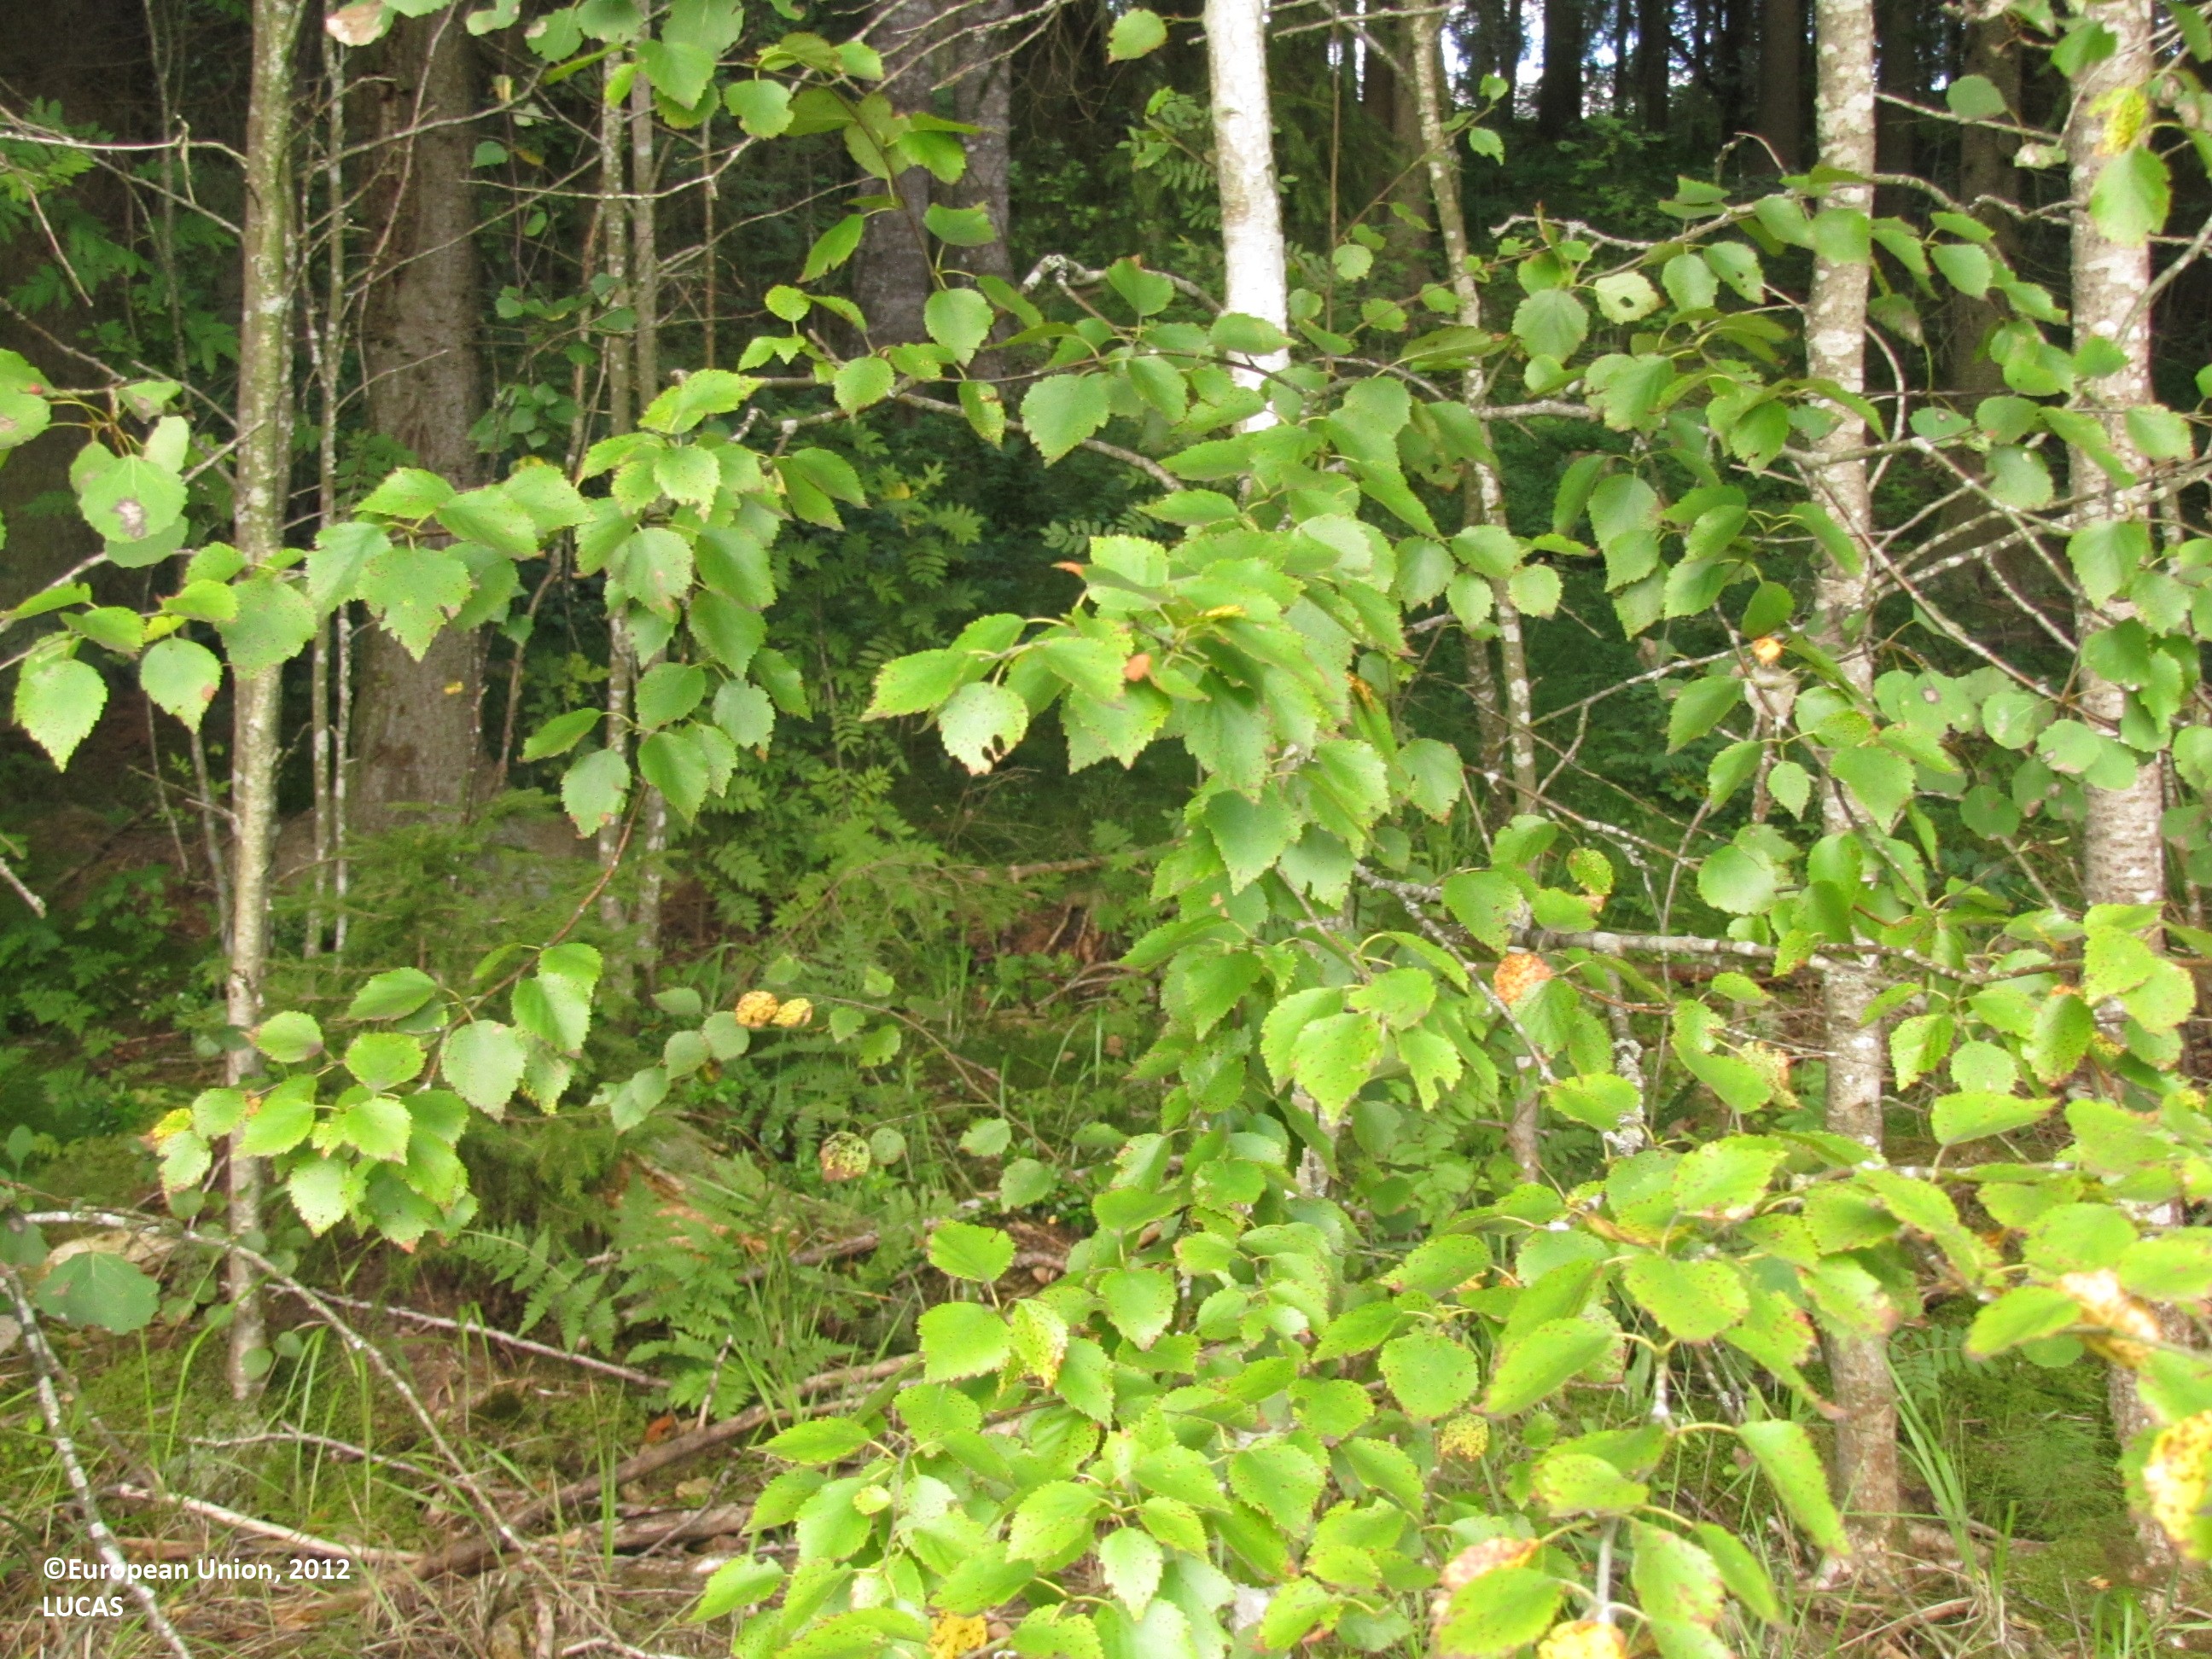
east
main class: Grassland
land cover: Grassland without tree/shrub cover
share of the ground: 50 - 75 %
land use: Agriculture (excluding fallow land and kitchen gardens)
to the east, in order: Grassland without tree/shrub cover; Fences; Ditches and canals; Spruce dominated coniferous woodland; Ditches and canals; Other leguminous and mixtures for fodder; Abandoned hedges; Ditches and canals; Spruce dominated coniferous woodland; Other leguminous and mixtures for fodder; Electric lines; Other leguminous and mixtures for fodder; Grass margins; Ditches and canals; Tracks; Grass margins; Ditches and canals; Grass margins; Other leguminous and mixtures for fodder
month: August
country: FI
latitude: 61.7412
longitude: 22.9238
